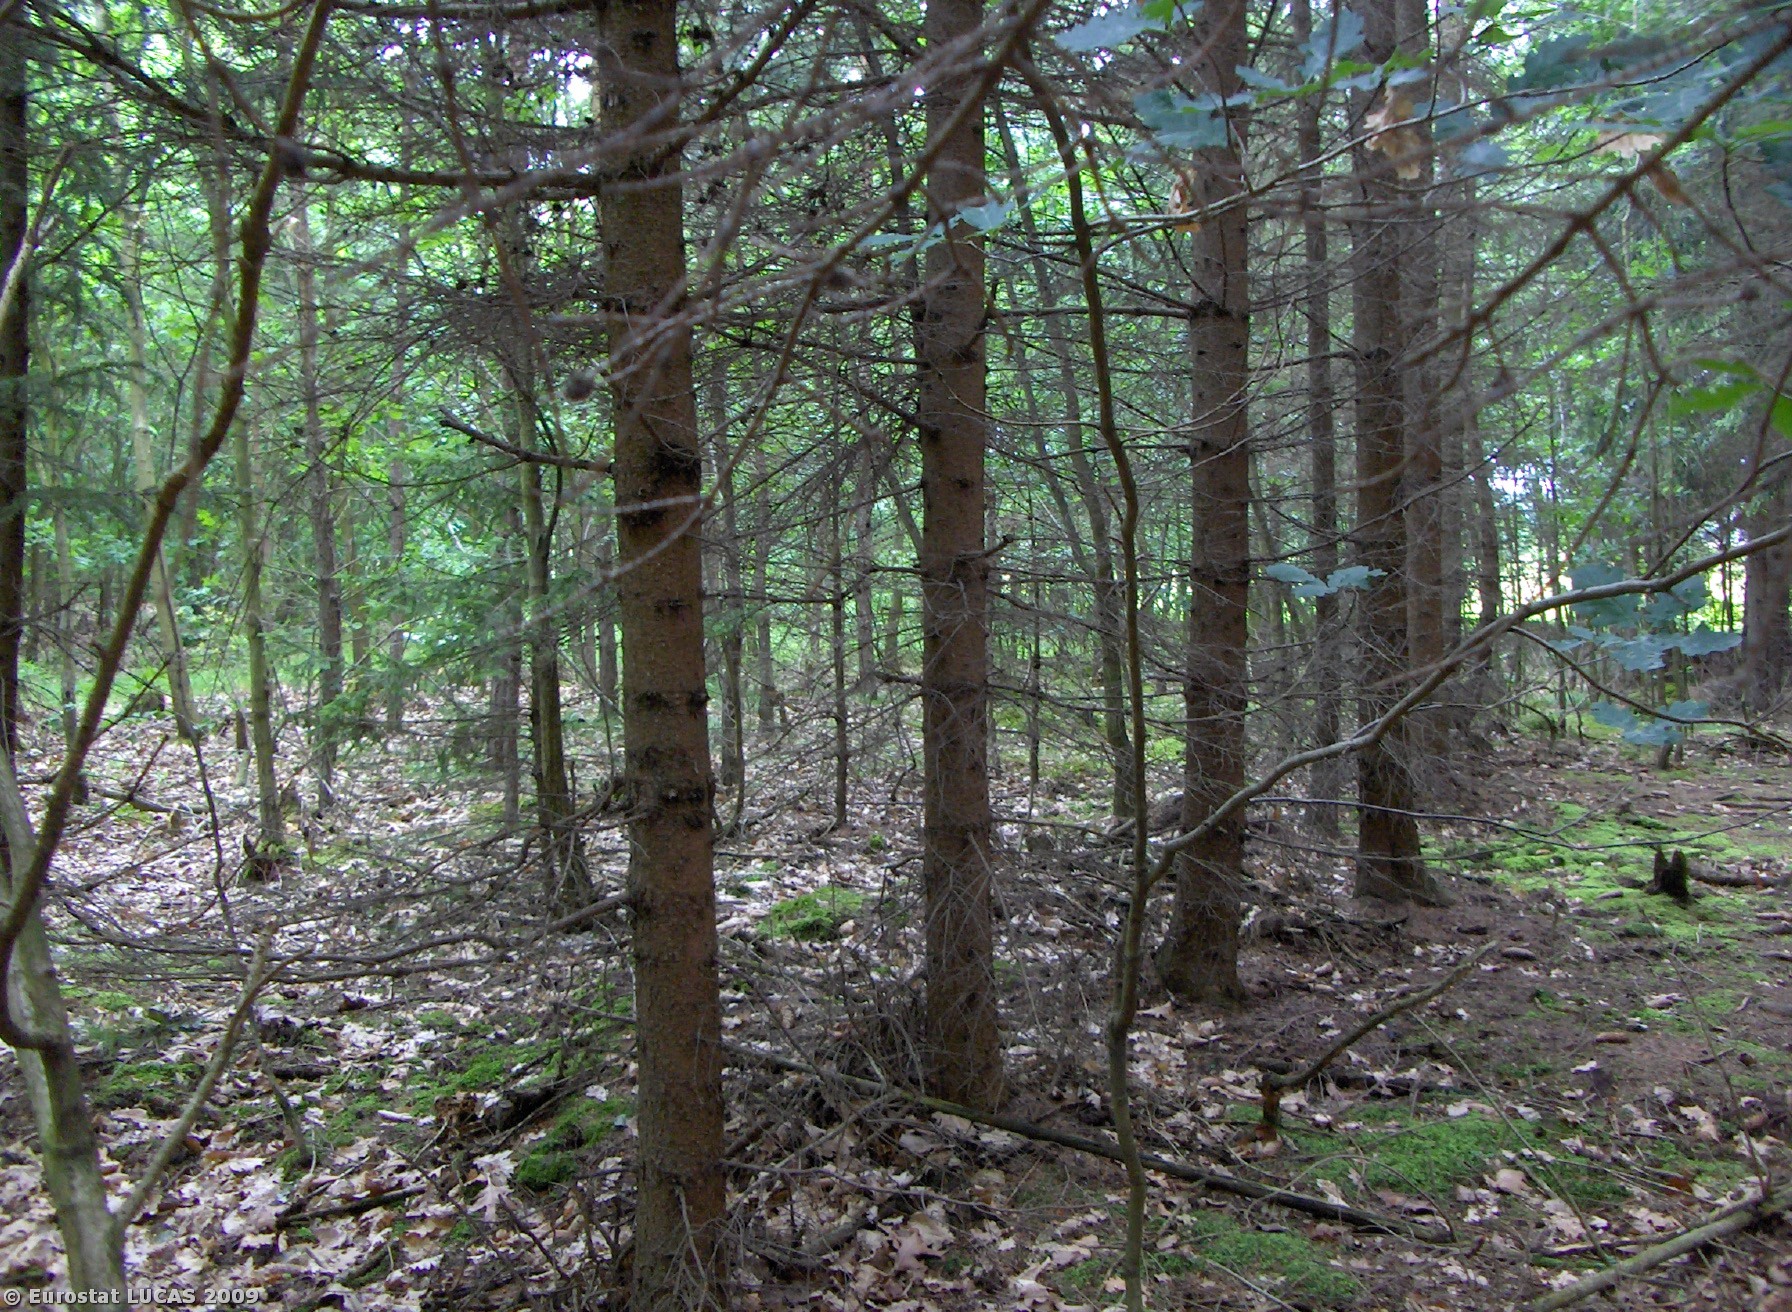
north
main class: Woodland
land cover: Coniferous woodland
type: hemiboreal forest and nemoral coniferous forest and mixed broadleaved-coniferous forest
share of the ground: > 75 %
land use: Forestry
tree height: > 5 m
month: June
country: CZ
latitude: 49.7993
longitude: 14.2386
